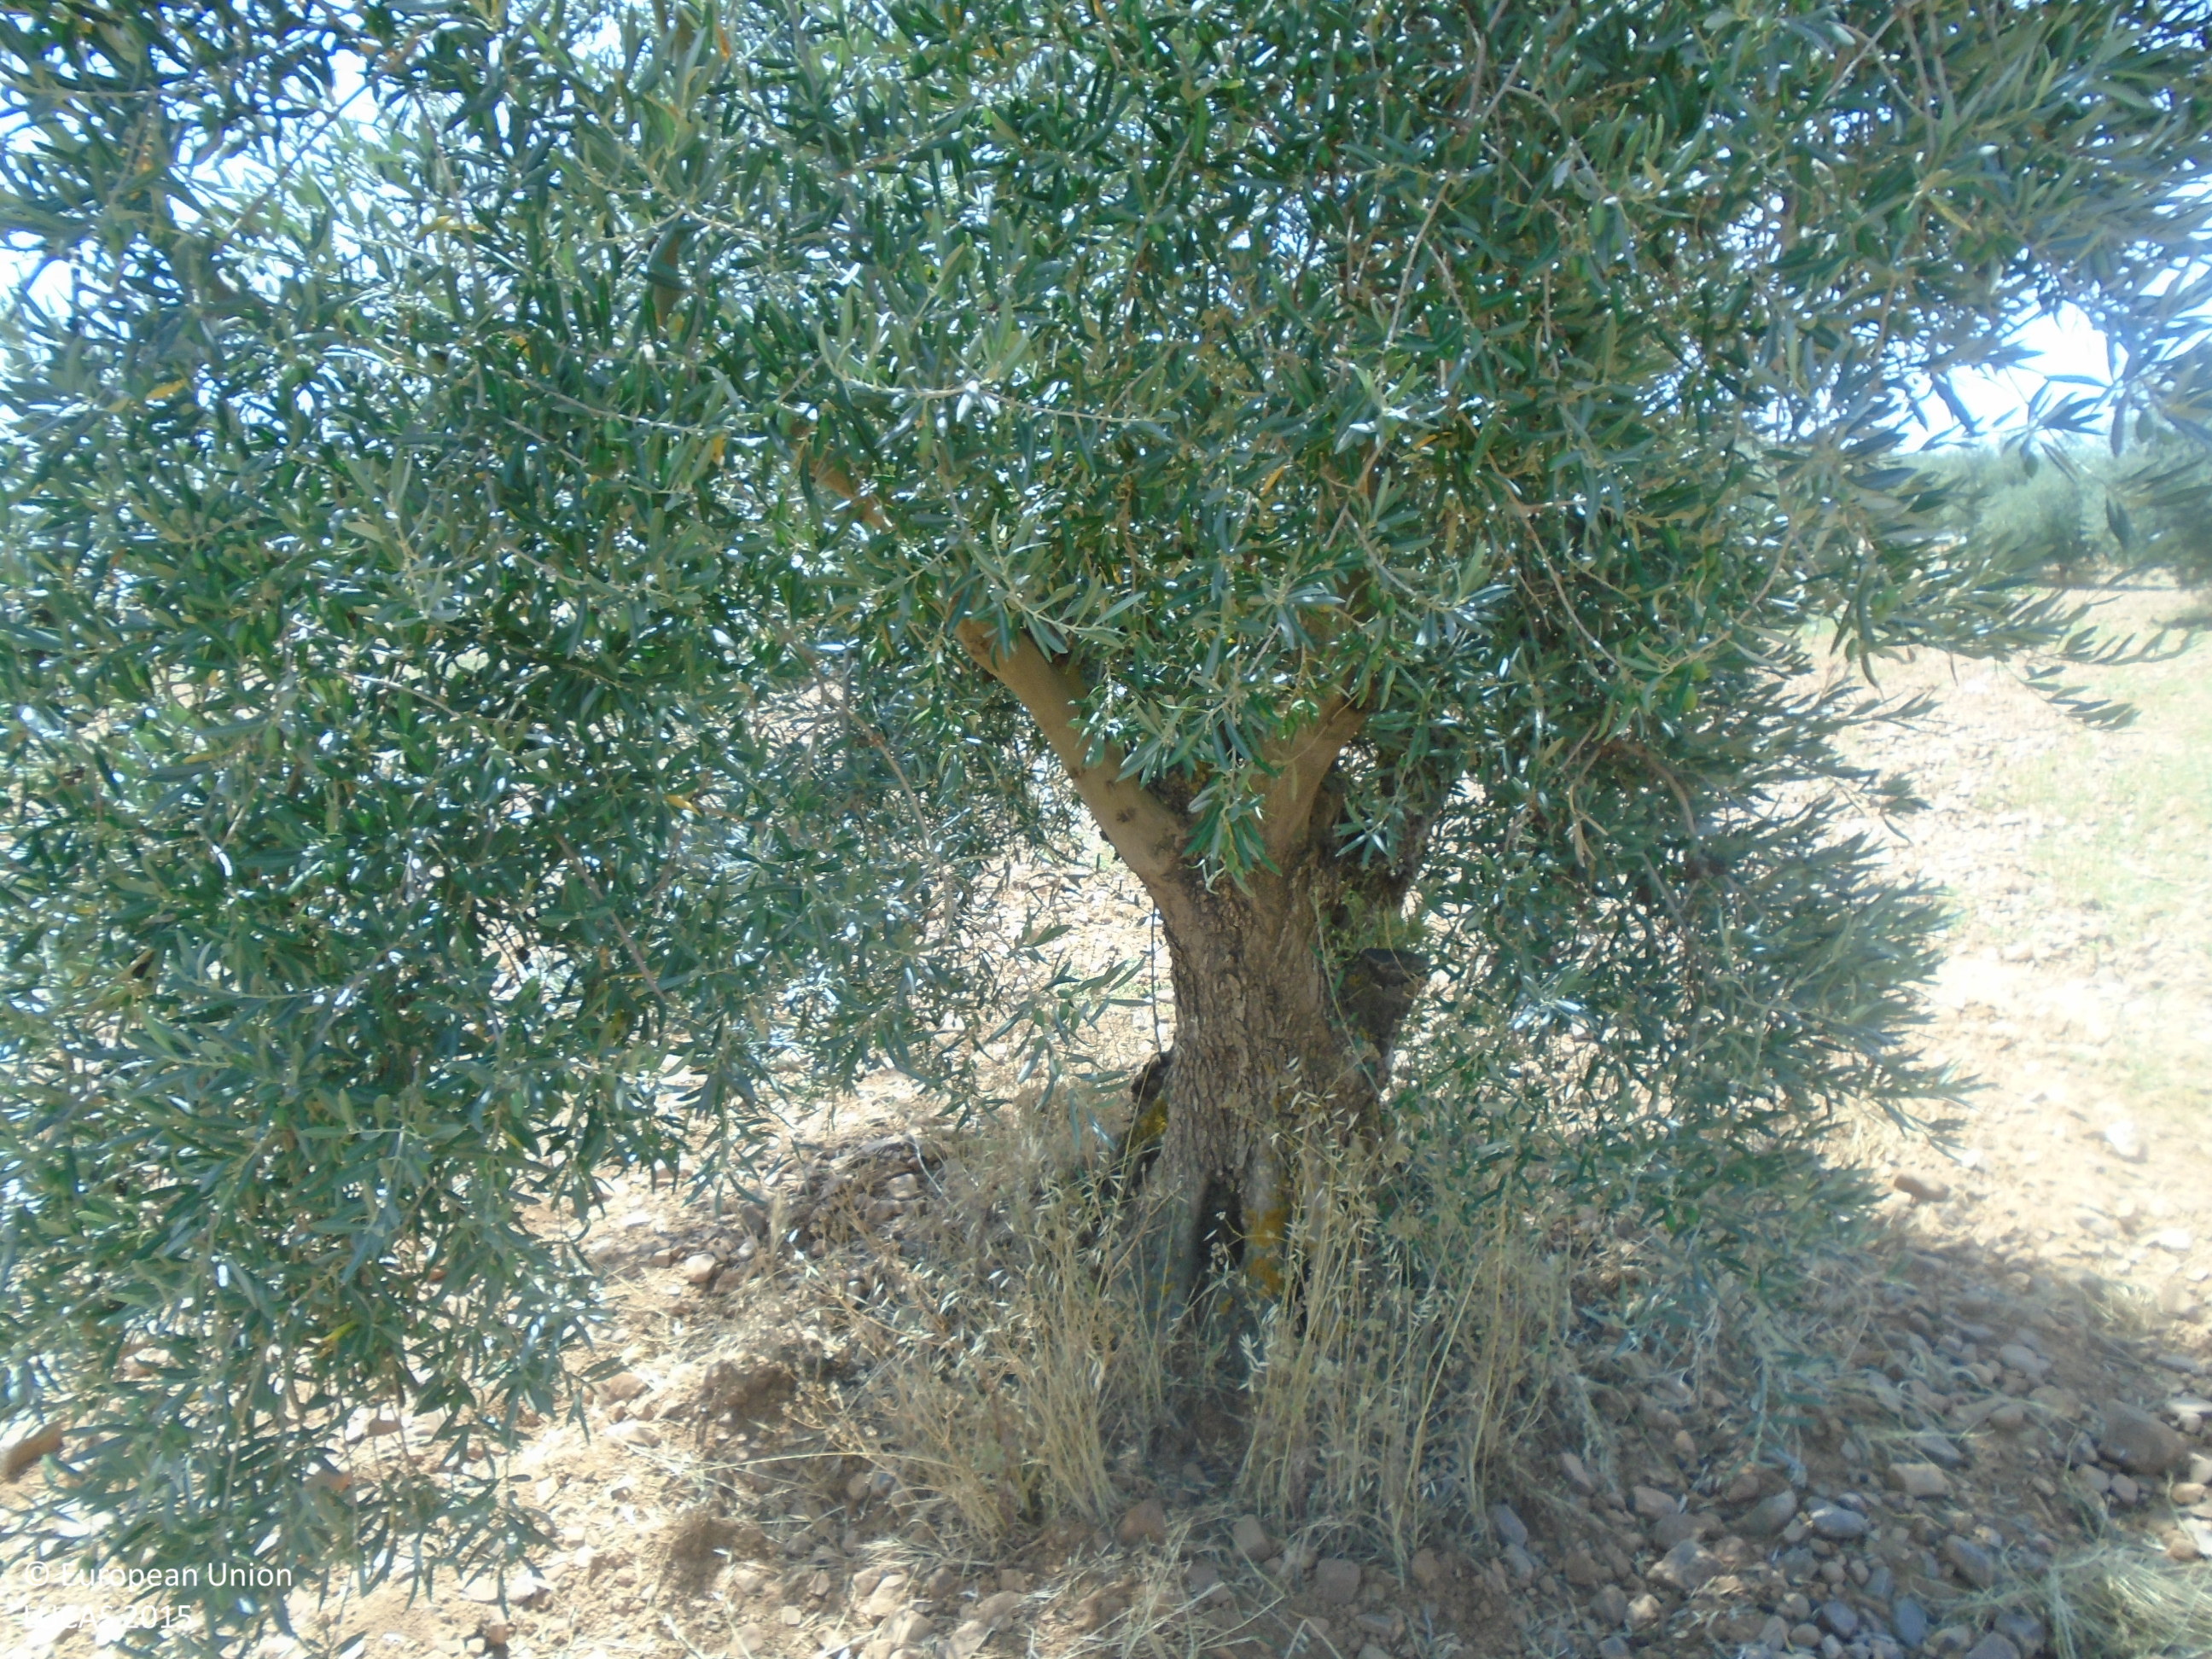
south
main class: Cropland
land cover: Olive groves
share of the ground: 25 - 50 %
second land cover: Other bare soil
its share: > 75 %
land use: Agriculture (excluding fallow land and kitchen gardens)
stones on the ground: 25 - 50 %
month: July
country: ES
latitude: 39.4283
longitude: -3.5797
